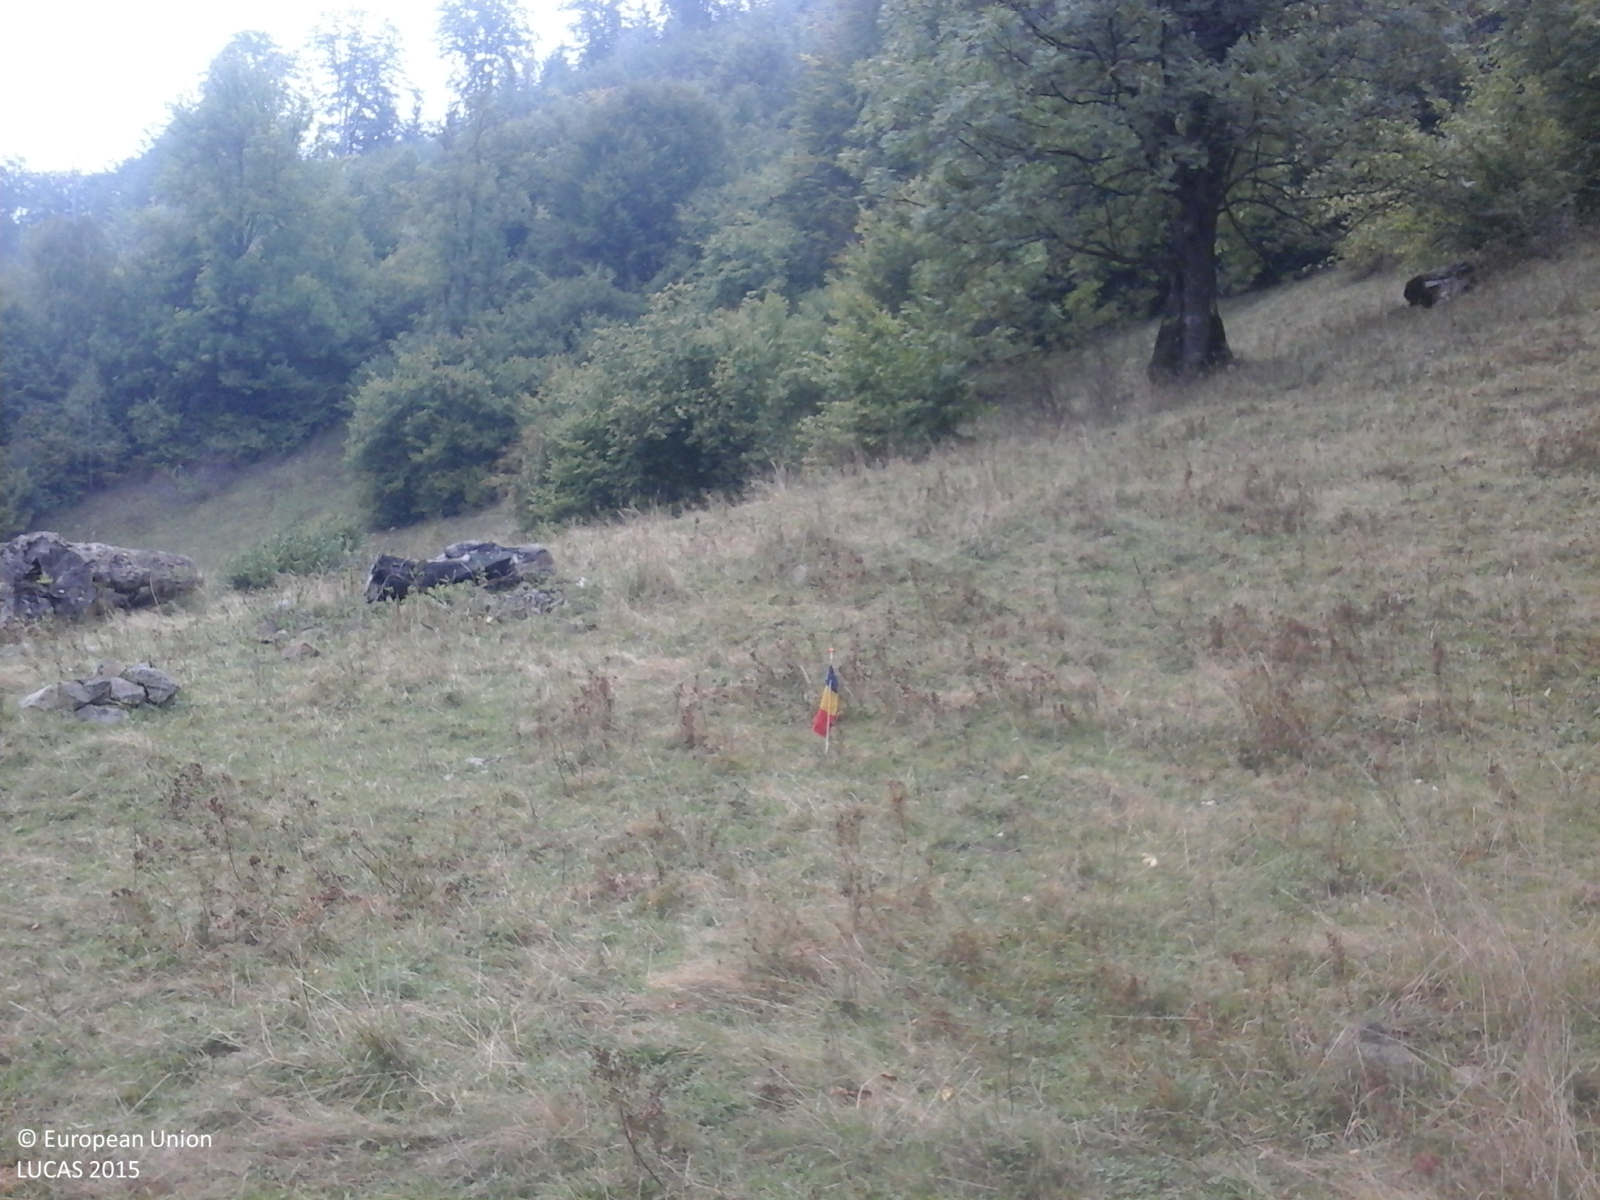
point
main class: Grassland
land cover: Grassland without tree/shrub cover
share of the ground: > 75 %
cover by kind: herbaceous plants 100 %
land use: Agriculture (excluding fallow land and kitchen gardens)
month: September
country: RO
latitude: 45.3690
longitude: 23.4530
